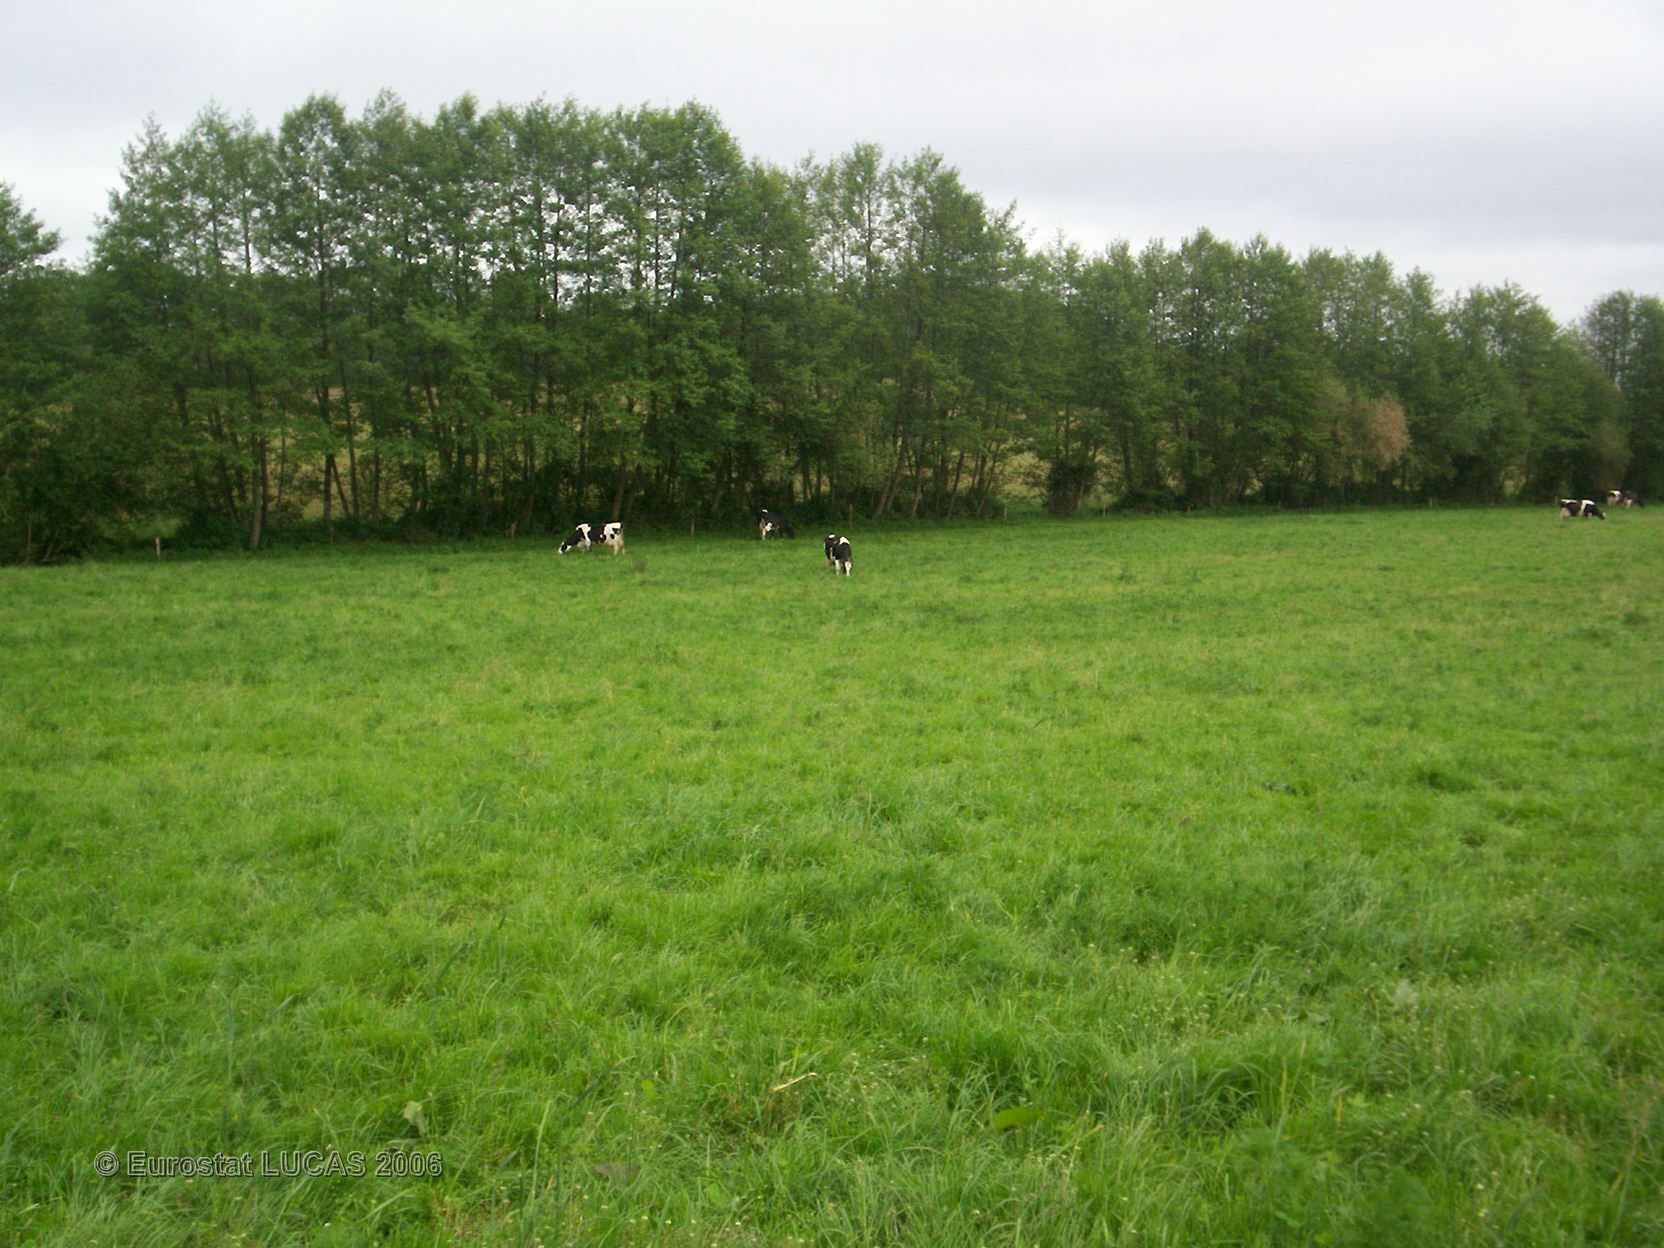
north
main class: Grassland
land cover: Grassland without tree/shrub cover
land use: Agriculture (excluding fallow land and kitchen gardens)
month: May
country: FR
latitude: 48.4300
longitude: 0.3103
